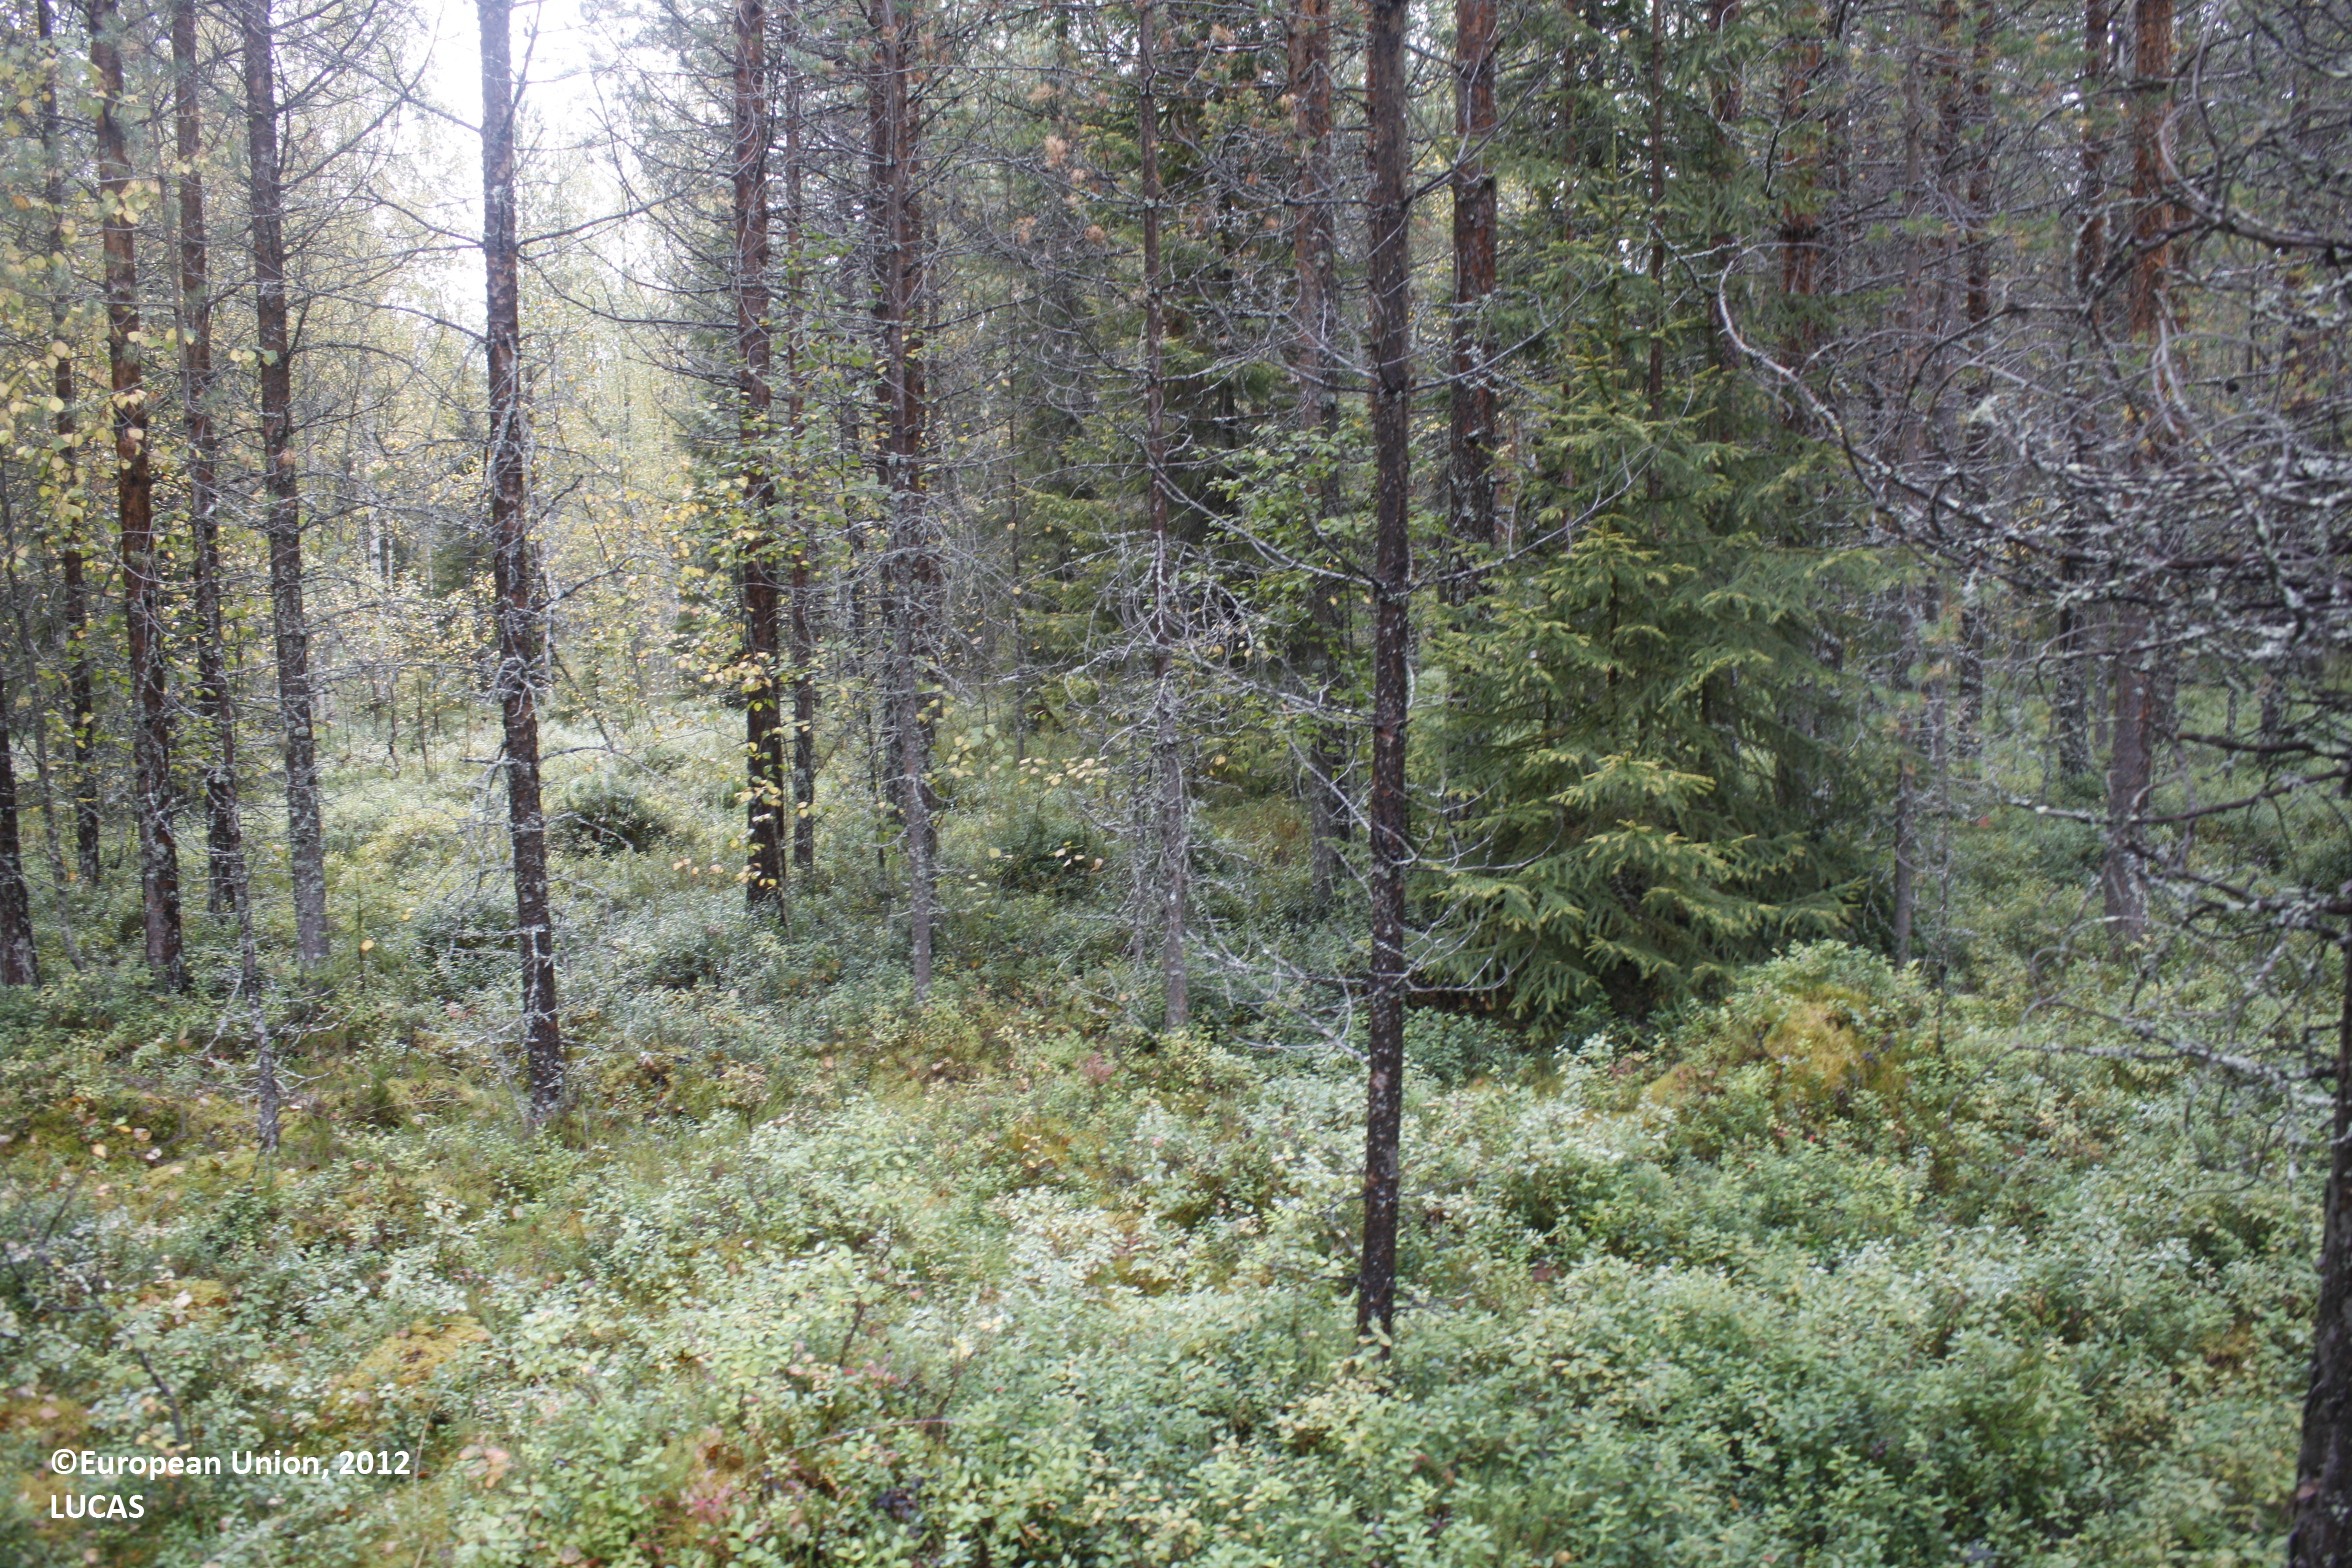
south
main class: Woodland
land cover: Pine dominated mixed woodland
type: boreal forest
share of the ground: 50 - 75 %
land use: Forestry
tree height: > 5 m
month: September
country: FI
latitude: 65.1747
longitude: 26.6969
